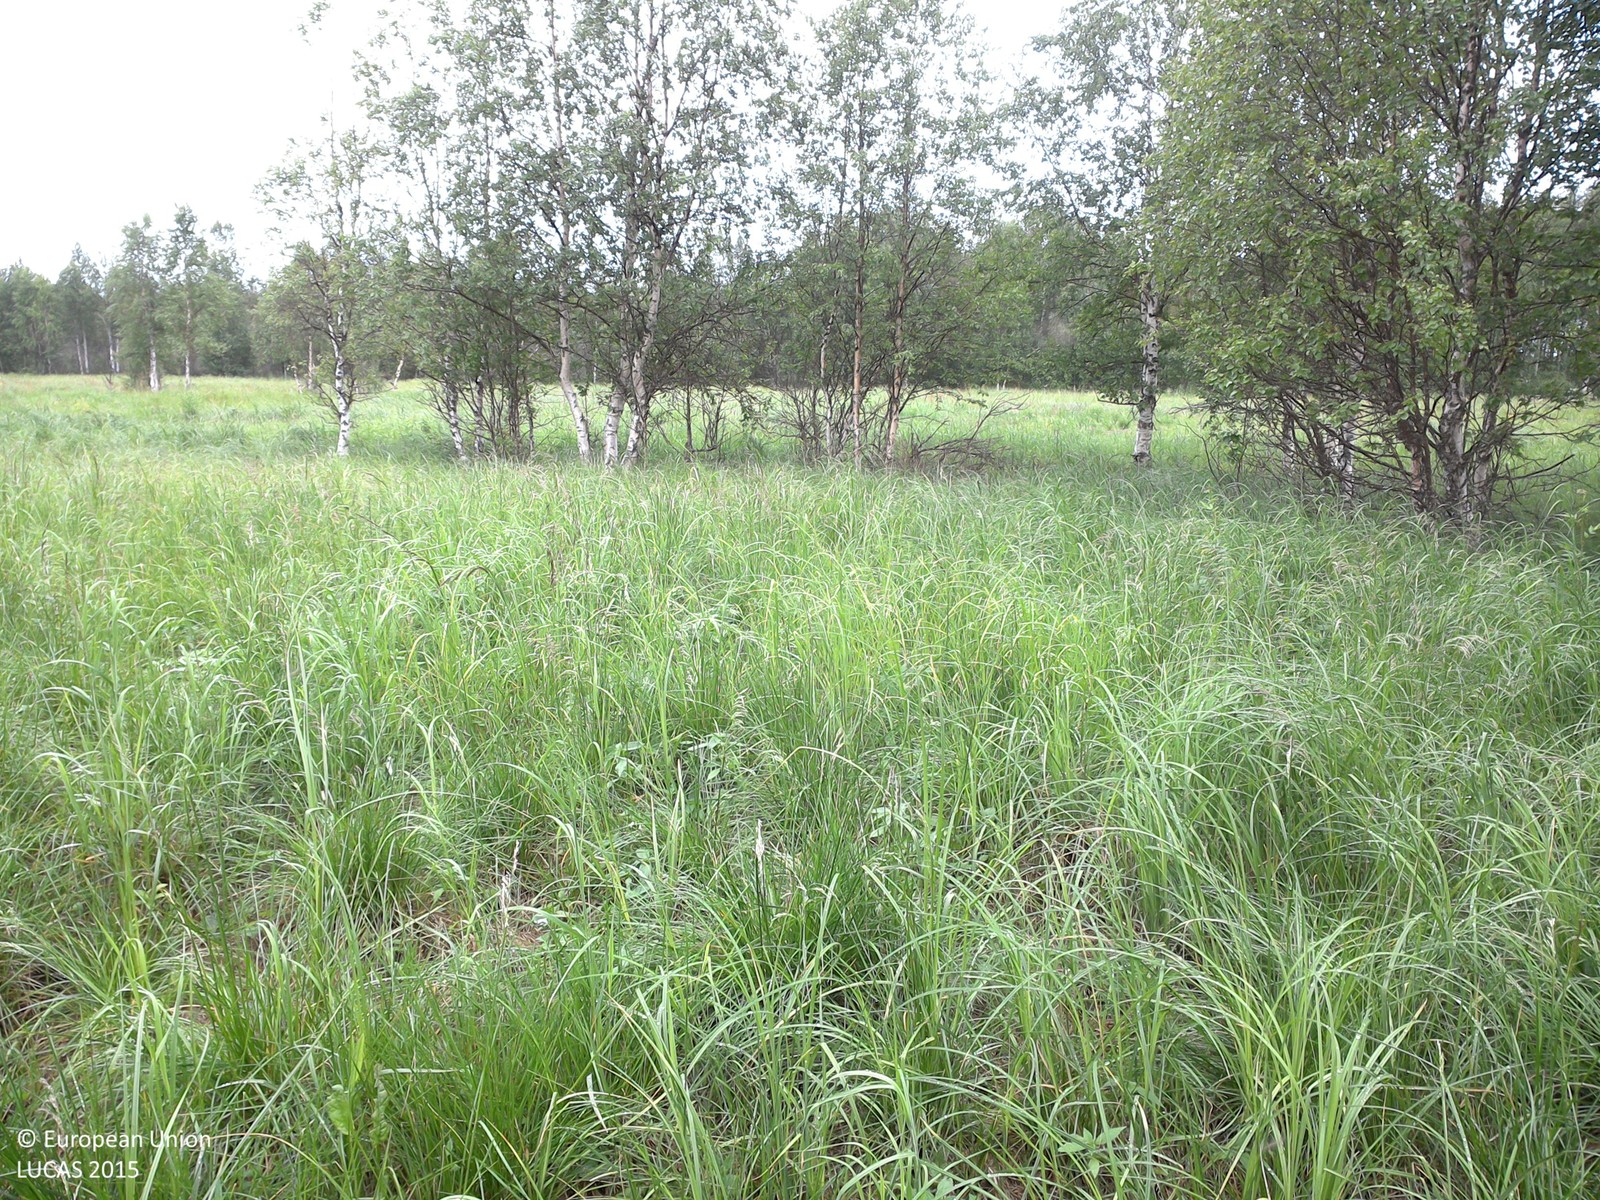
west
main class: Grassland
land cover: Grassland without tree/shrub cover
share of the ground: > 75 %
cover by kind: herbaceous plants 100 %
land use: Agriculture (excluding fallow land and kitchen gardens)
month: July
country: SE
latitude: 66.9155
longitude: 23.6707
